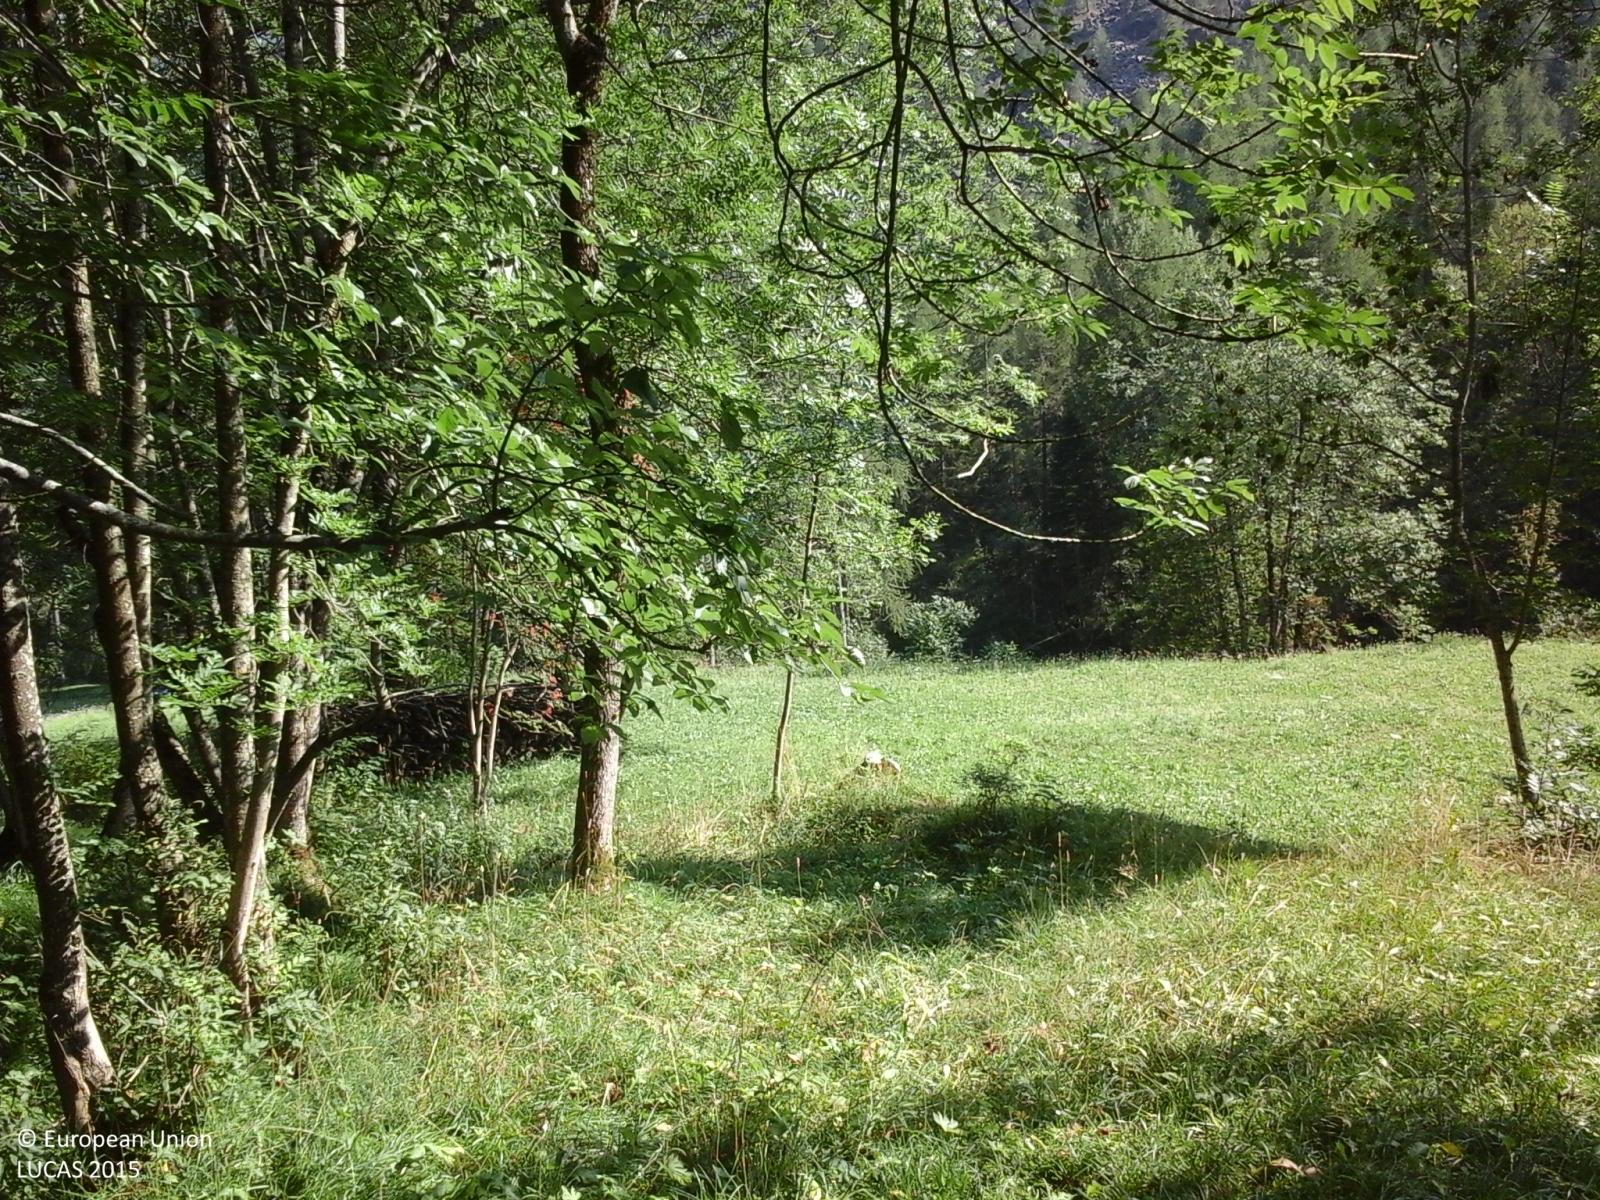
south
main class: Woodland
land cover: Broadleaved woodland
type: thermophilous deciduous forest
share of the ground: > 75 %
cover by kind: broadleaved forest trees 70 %, herbaceous plants 20 %, shrubs 10 %
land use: Forestry
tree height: > 5 m
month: August
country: IT
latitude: 45.6221
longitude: 7.6308
